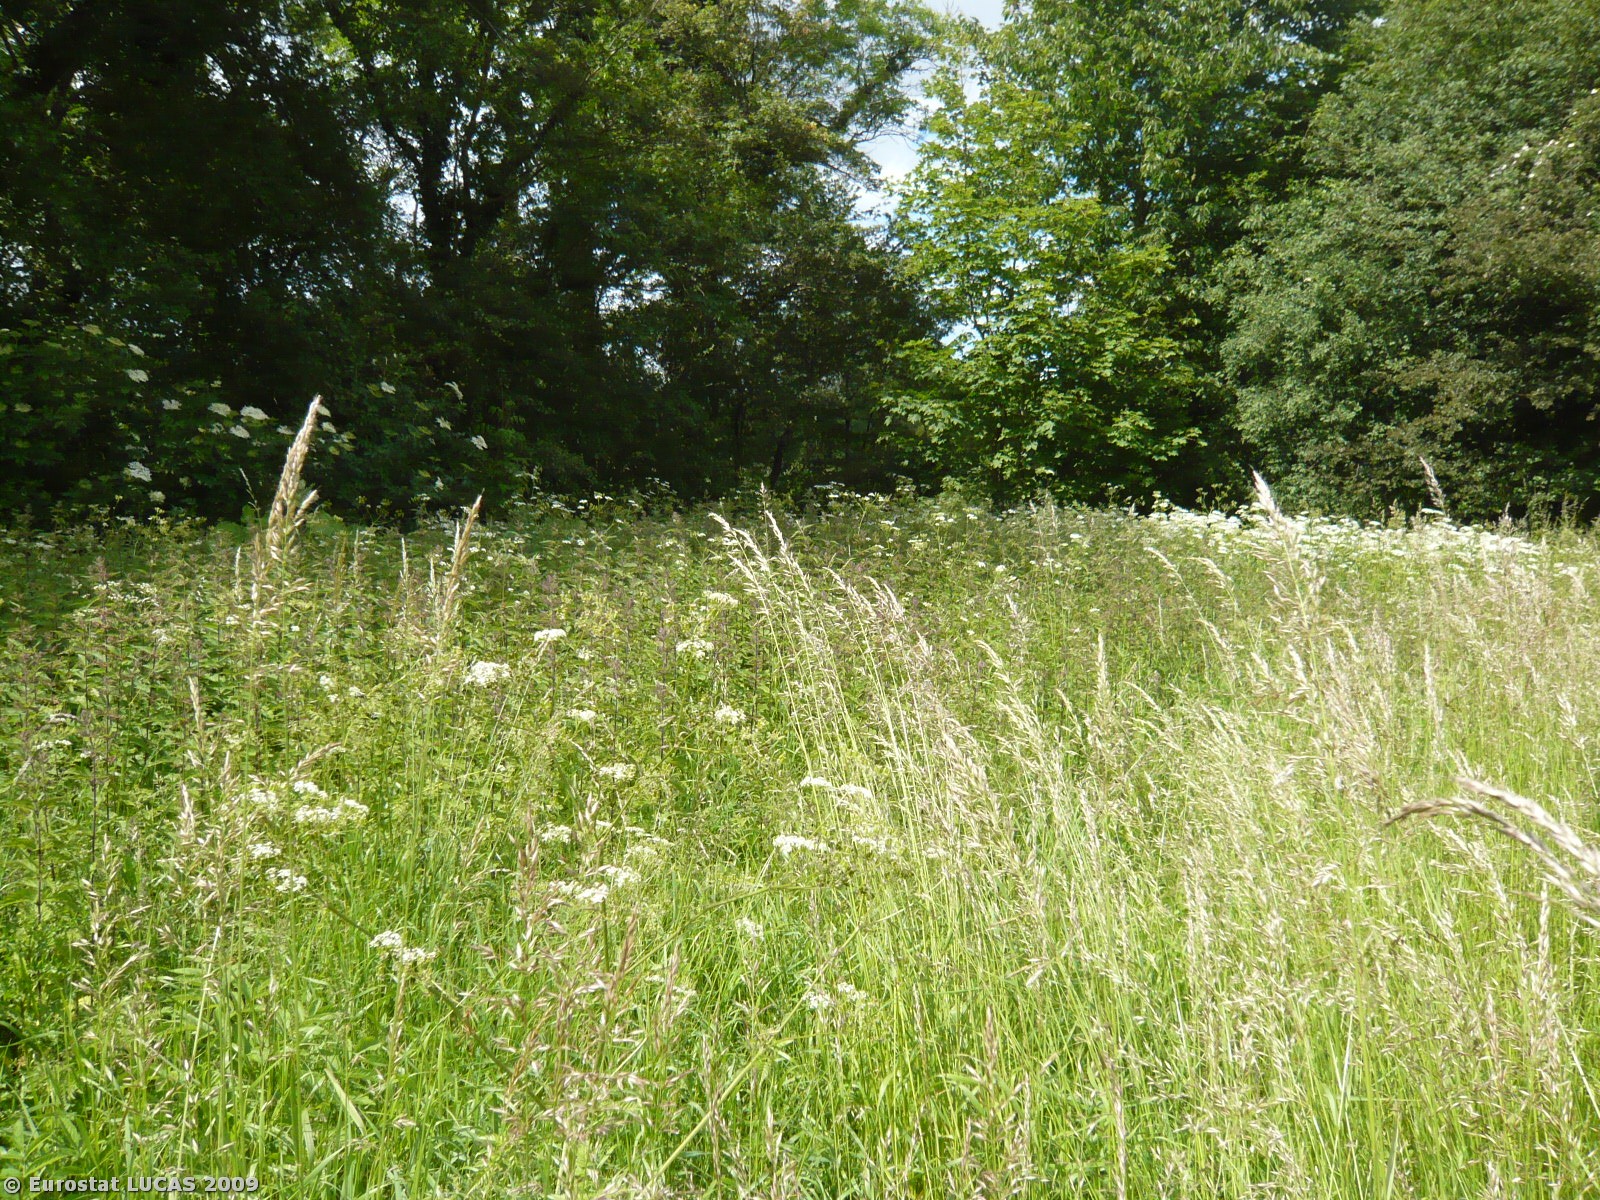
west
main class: Grassland
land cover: Grassland without tree/shrub cover
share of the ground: > 75 %
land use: Agriculture (excluding fallow land and kitchen gardens)
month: June
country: DK
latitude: 54.7563
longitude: 11.6926
